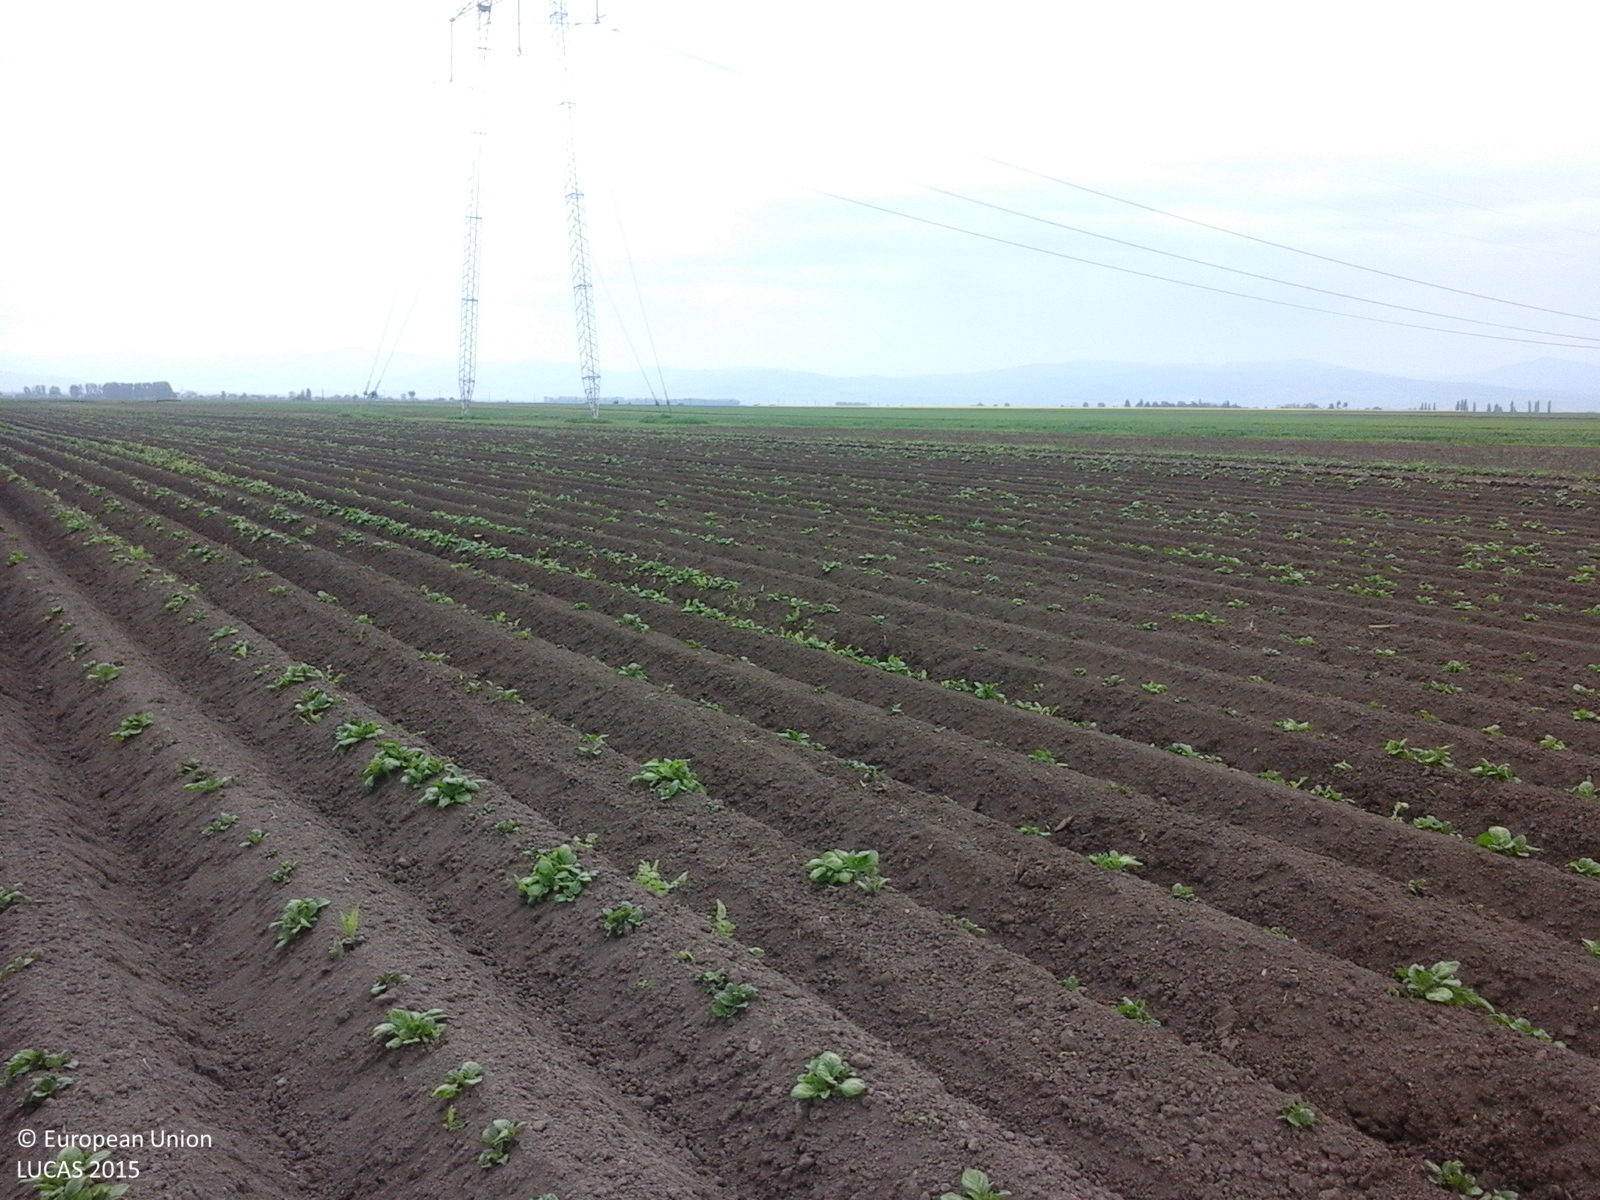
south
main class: Cropland
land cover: Potatoes
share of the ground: < 10 %
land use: Agriculture (excluding fallow land and kitchen gardens)
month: May
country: RO
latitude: 45.8845
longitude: 26.0306
